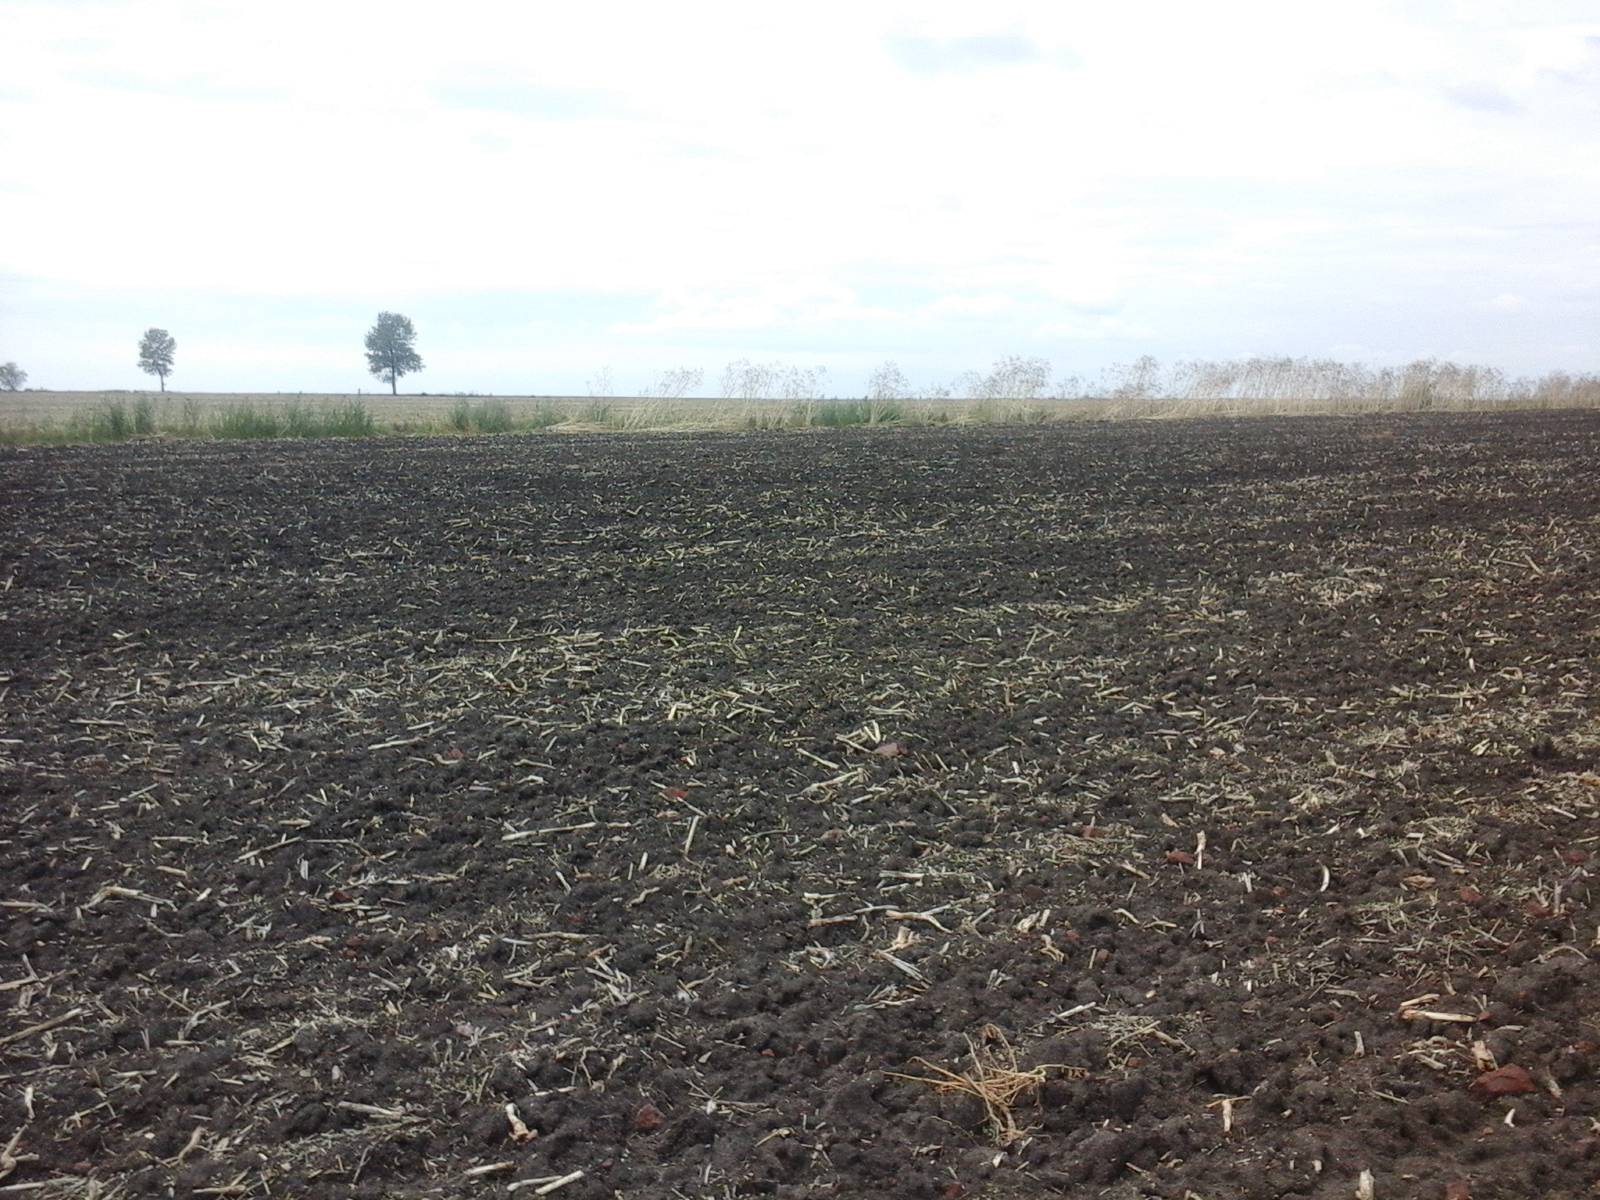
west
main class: Cropland
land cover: Rape and turnip rape
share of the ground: < 10 %
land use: Agriculture (excluding fallow land and kitchen gardens)
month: August
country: RO
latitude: 45.5104
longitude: 21.3328
